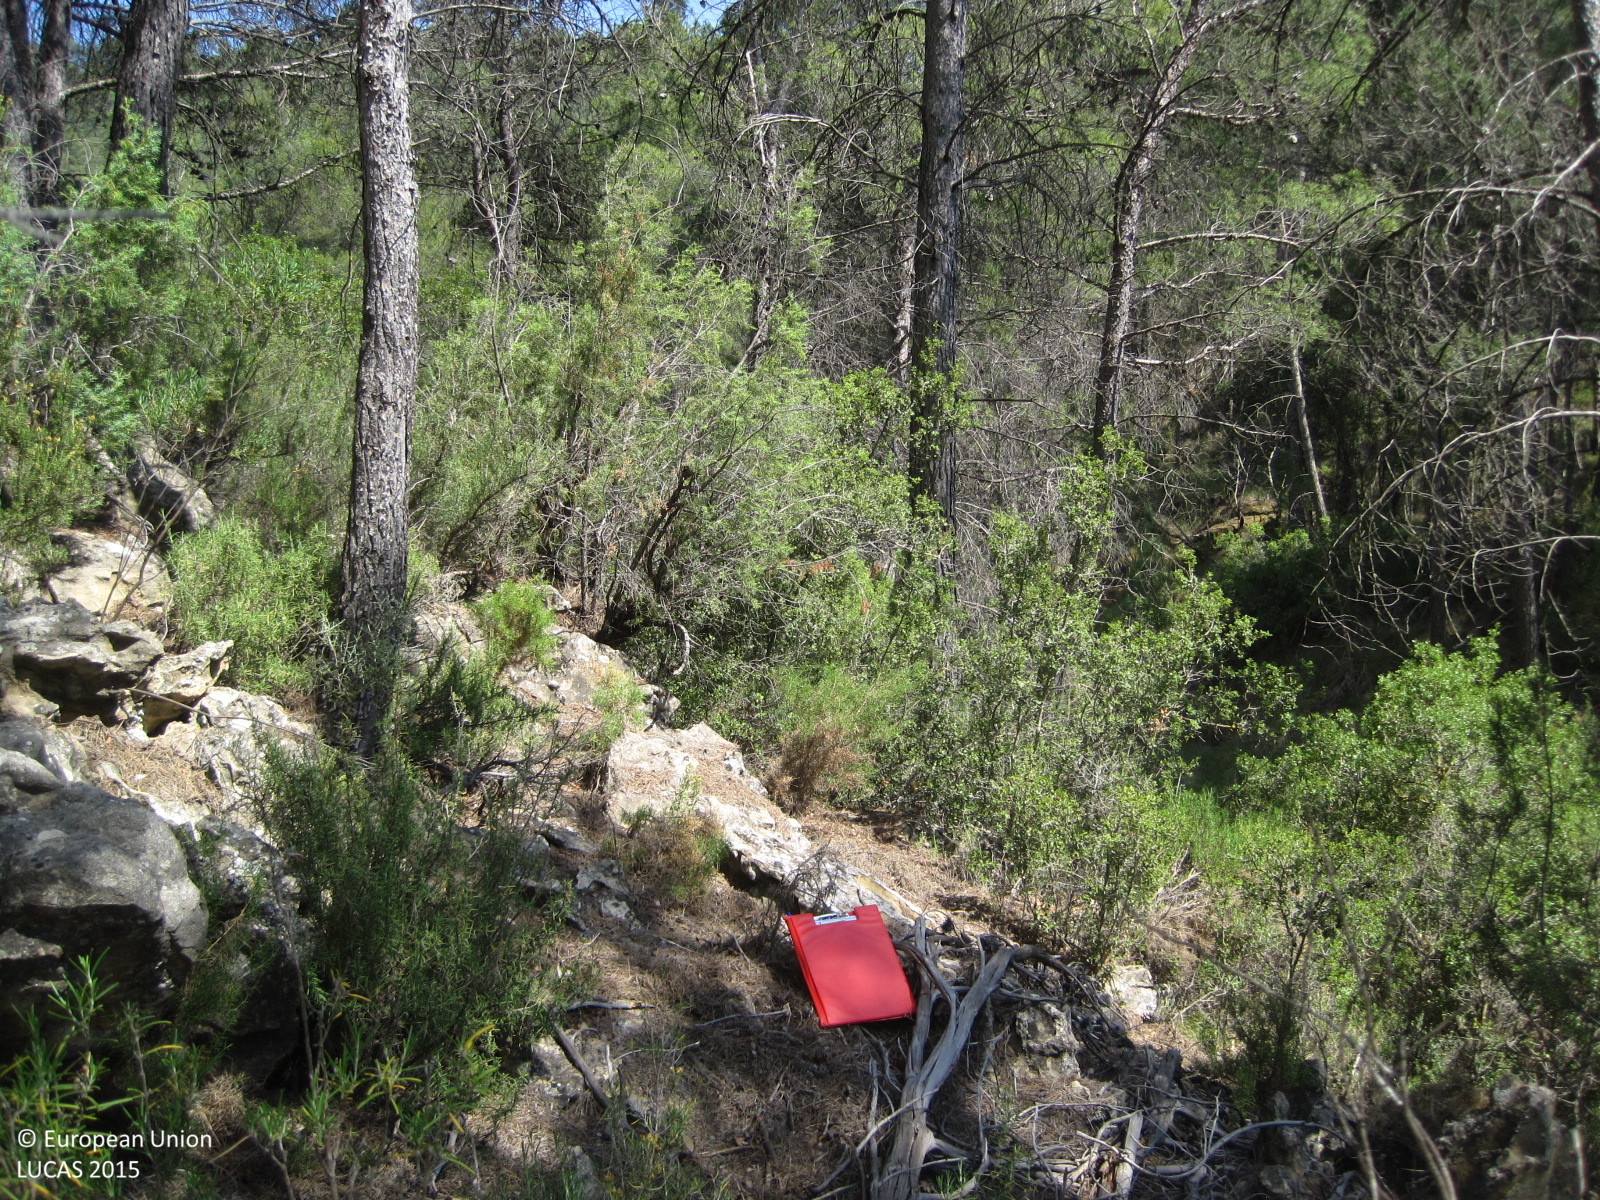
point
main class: Woodland
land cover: Pine dominated coniferous woodland
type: coniferous forest of the mediterranean region
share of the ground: 25 - 50 %
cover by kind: coniferous forest trees 40 %, shrubs 40 %, herbaceous plants 10 %, consolidated bare surface 10 %
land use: Forestry
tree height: > 5 m
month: June
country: ES
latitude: 39.7036
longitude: -1.1421
